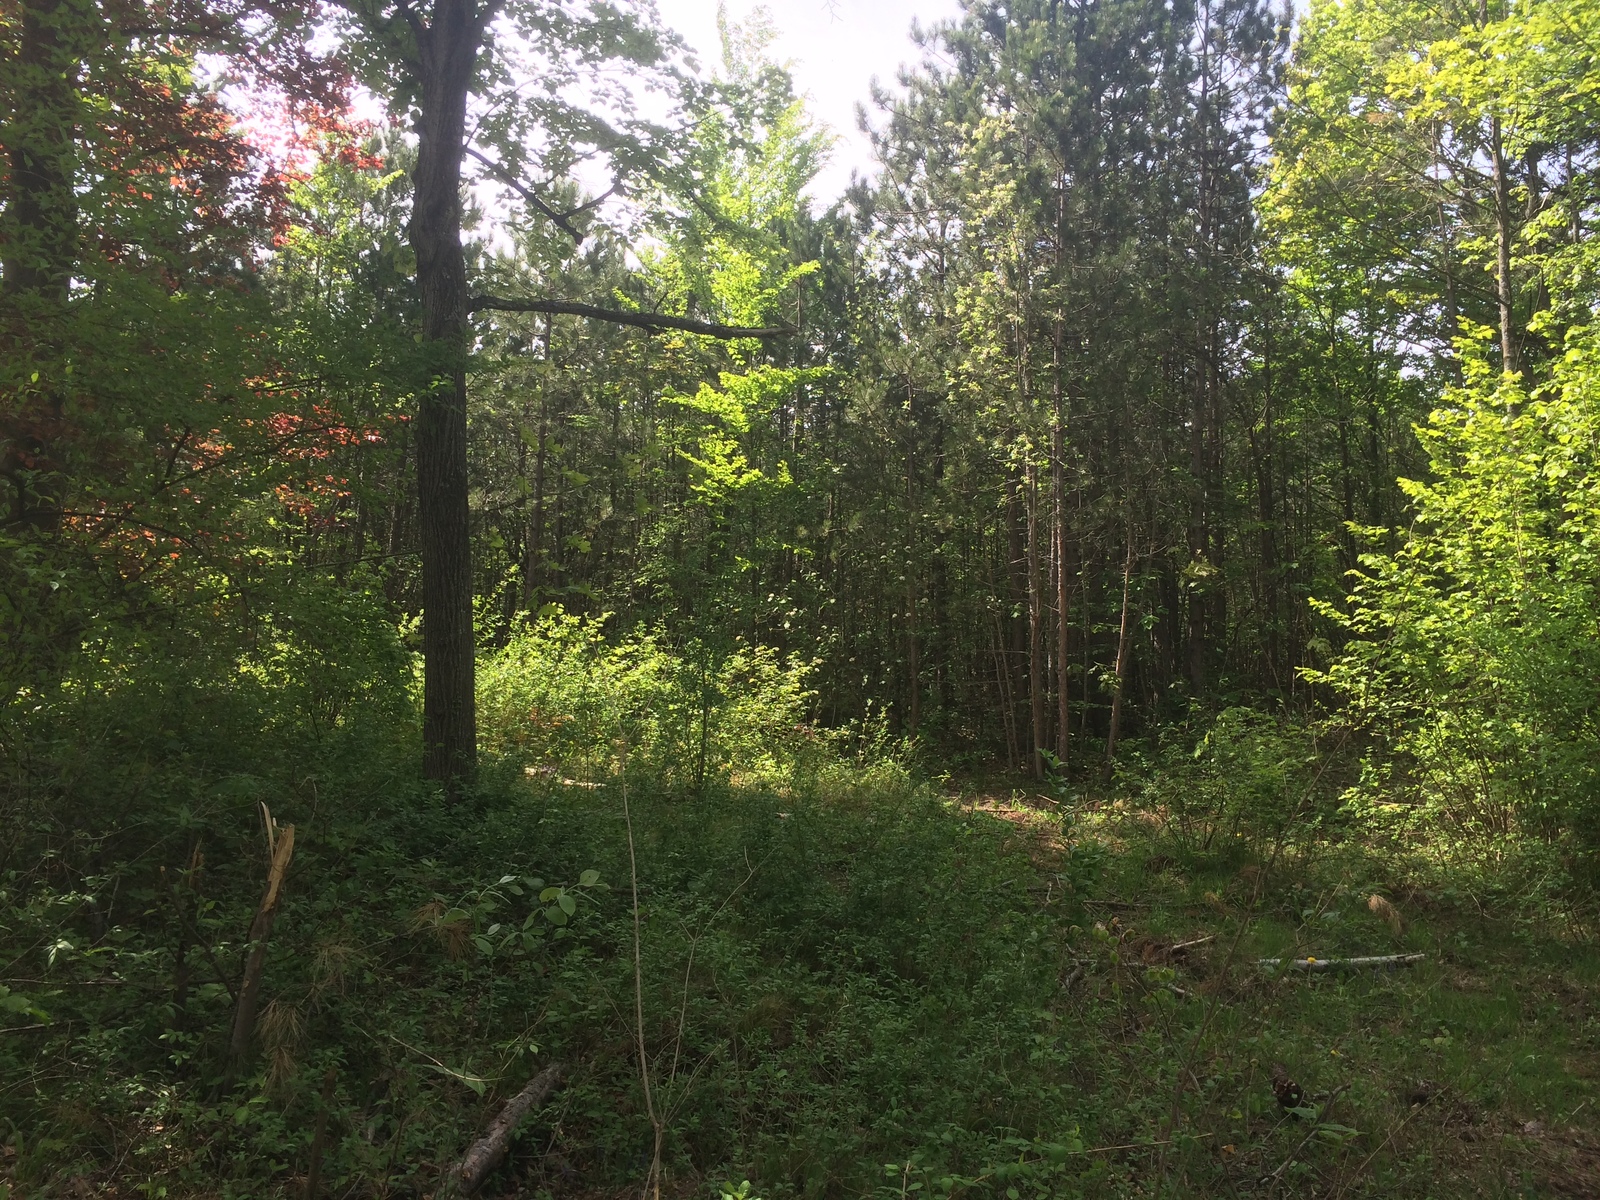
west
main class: Woodland
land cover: Pine dominated mixed woodland
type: alpine coniferous forest
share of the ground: > 75 %
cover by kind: coniferous forest trees 40 %, broadleaved forest trees 40 %, shrubs 10 %, herbaceous plants 10 %
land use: Forestry
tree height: > 5 m
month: May
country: AT
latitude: 47.9242
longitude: 16.1733
